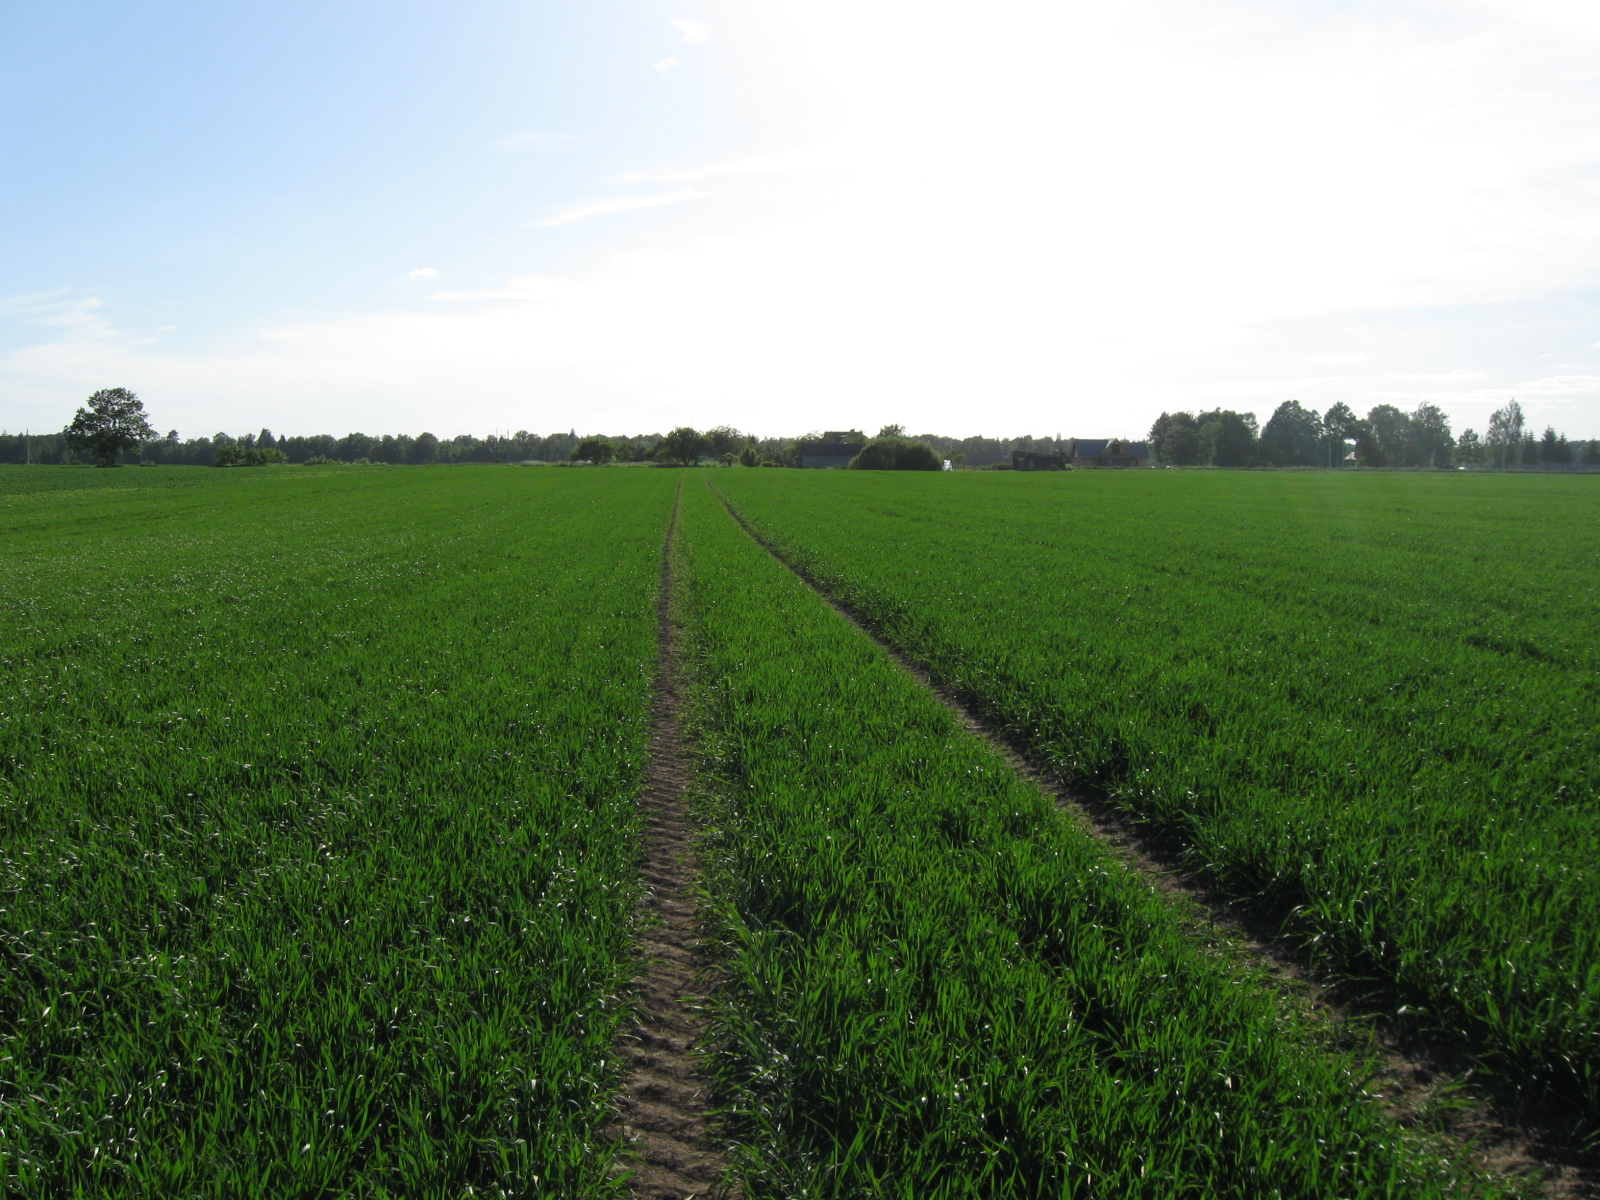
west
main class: Cropland
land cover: Common wheat
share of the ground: > 75 %
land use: Agriculture (excluding fallow land and kitchen gardens)
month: June
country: LT
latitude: 55.0553
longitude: 23.7839
